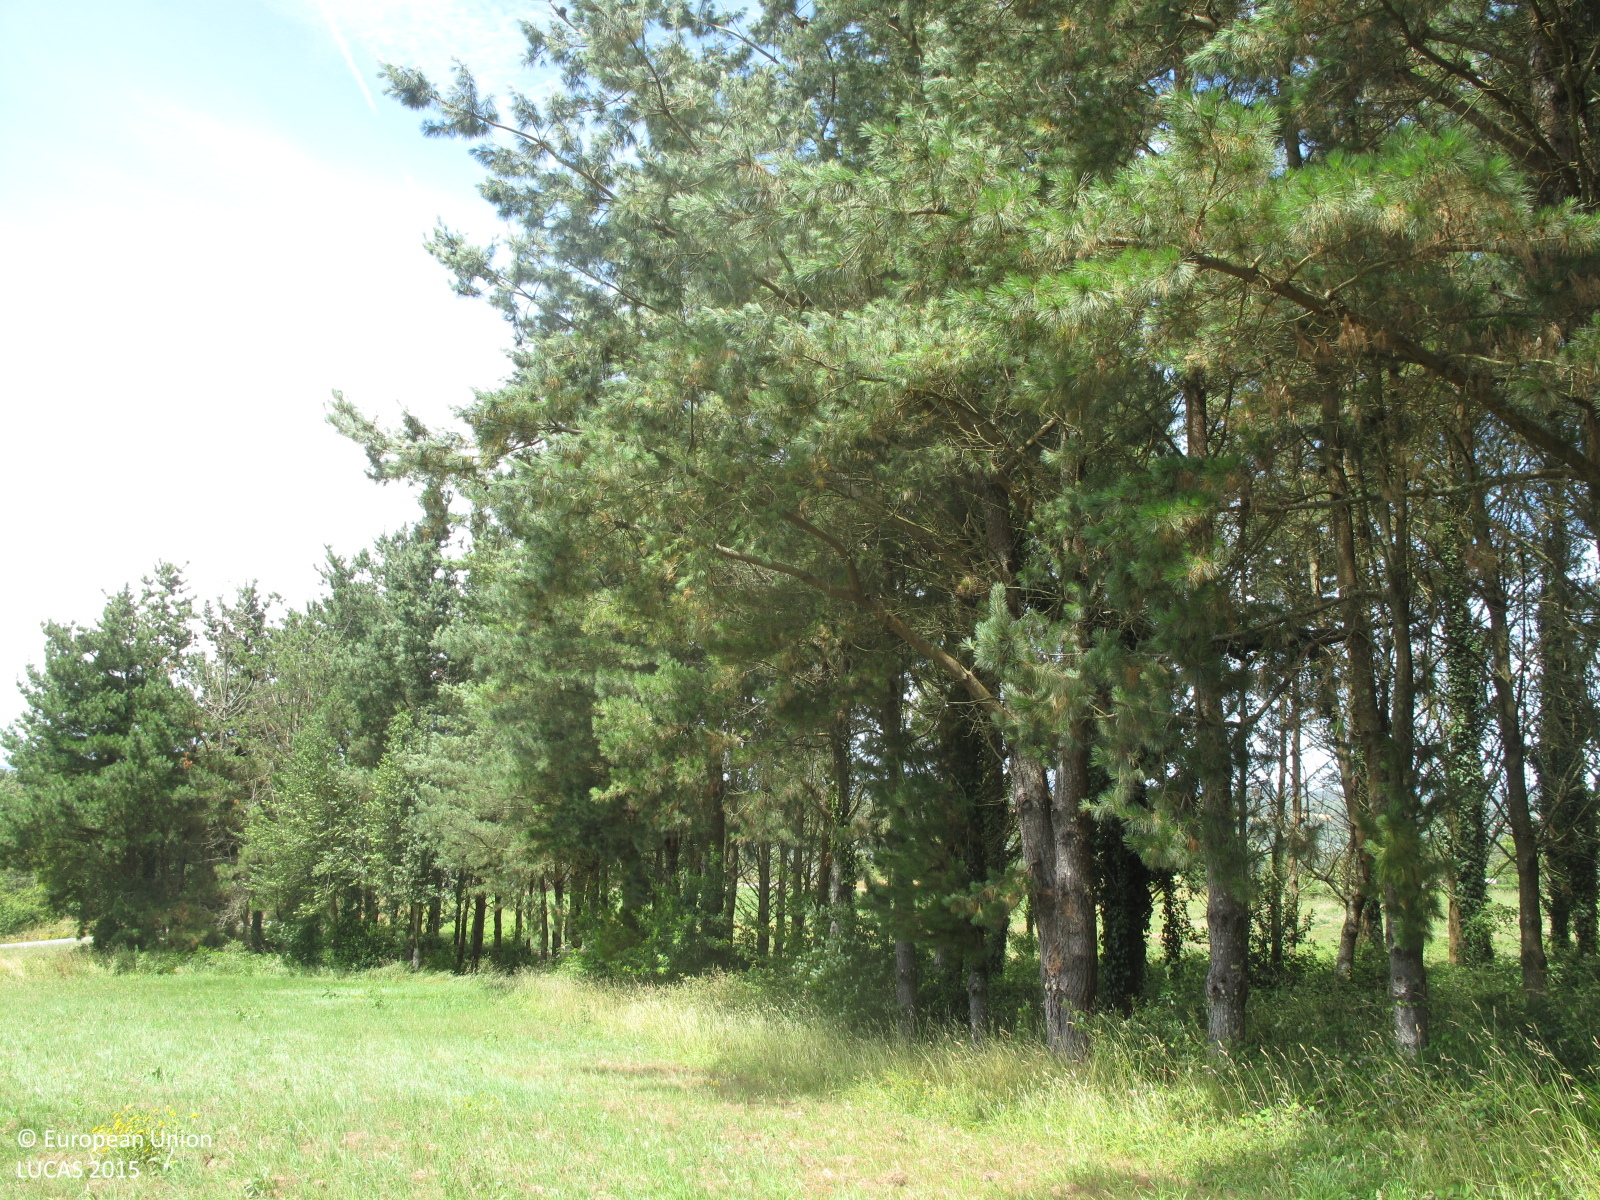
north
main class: Grassland
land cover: Grassland without tree/shrub cover
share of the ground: 50 - 75 %
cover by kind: herbaceous plants 70 %, unconsolidated bare surface 30 %
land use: Agriculture (excluding fallow land and kitchen gardens)
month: July
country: ES
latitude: 43.1856
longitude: -8.6034
